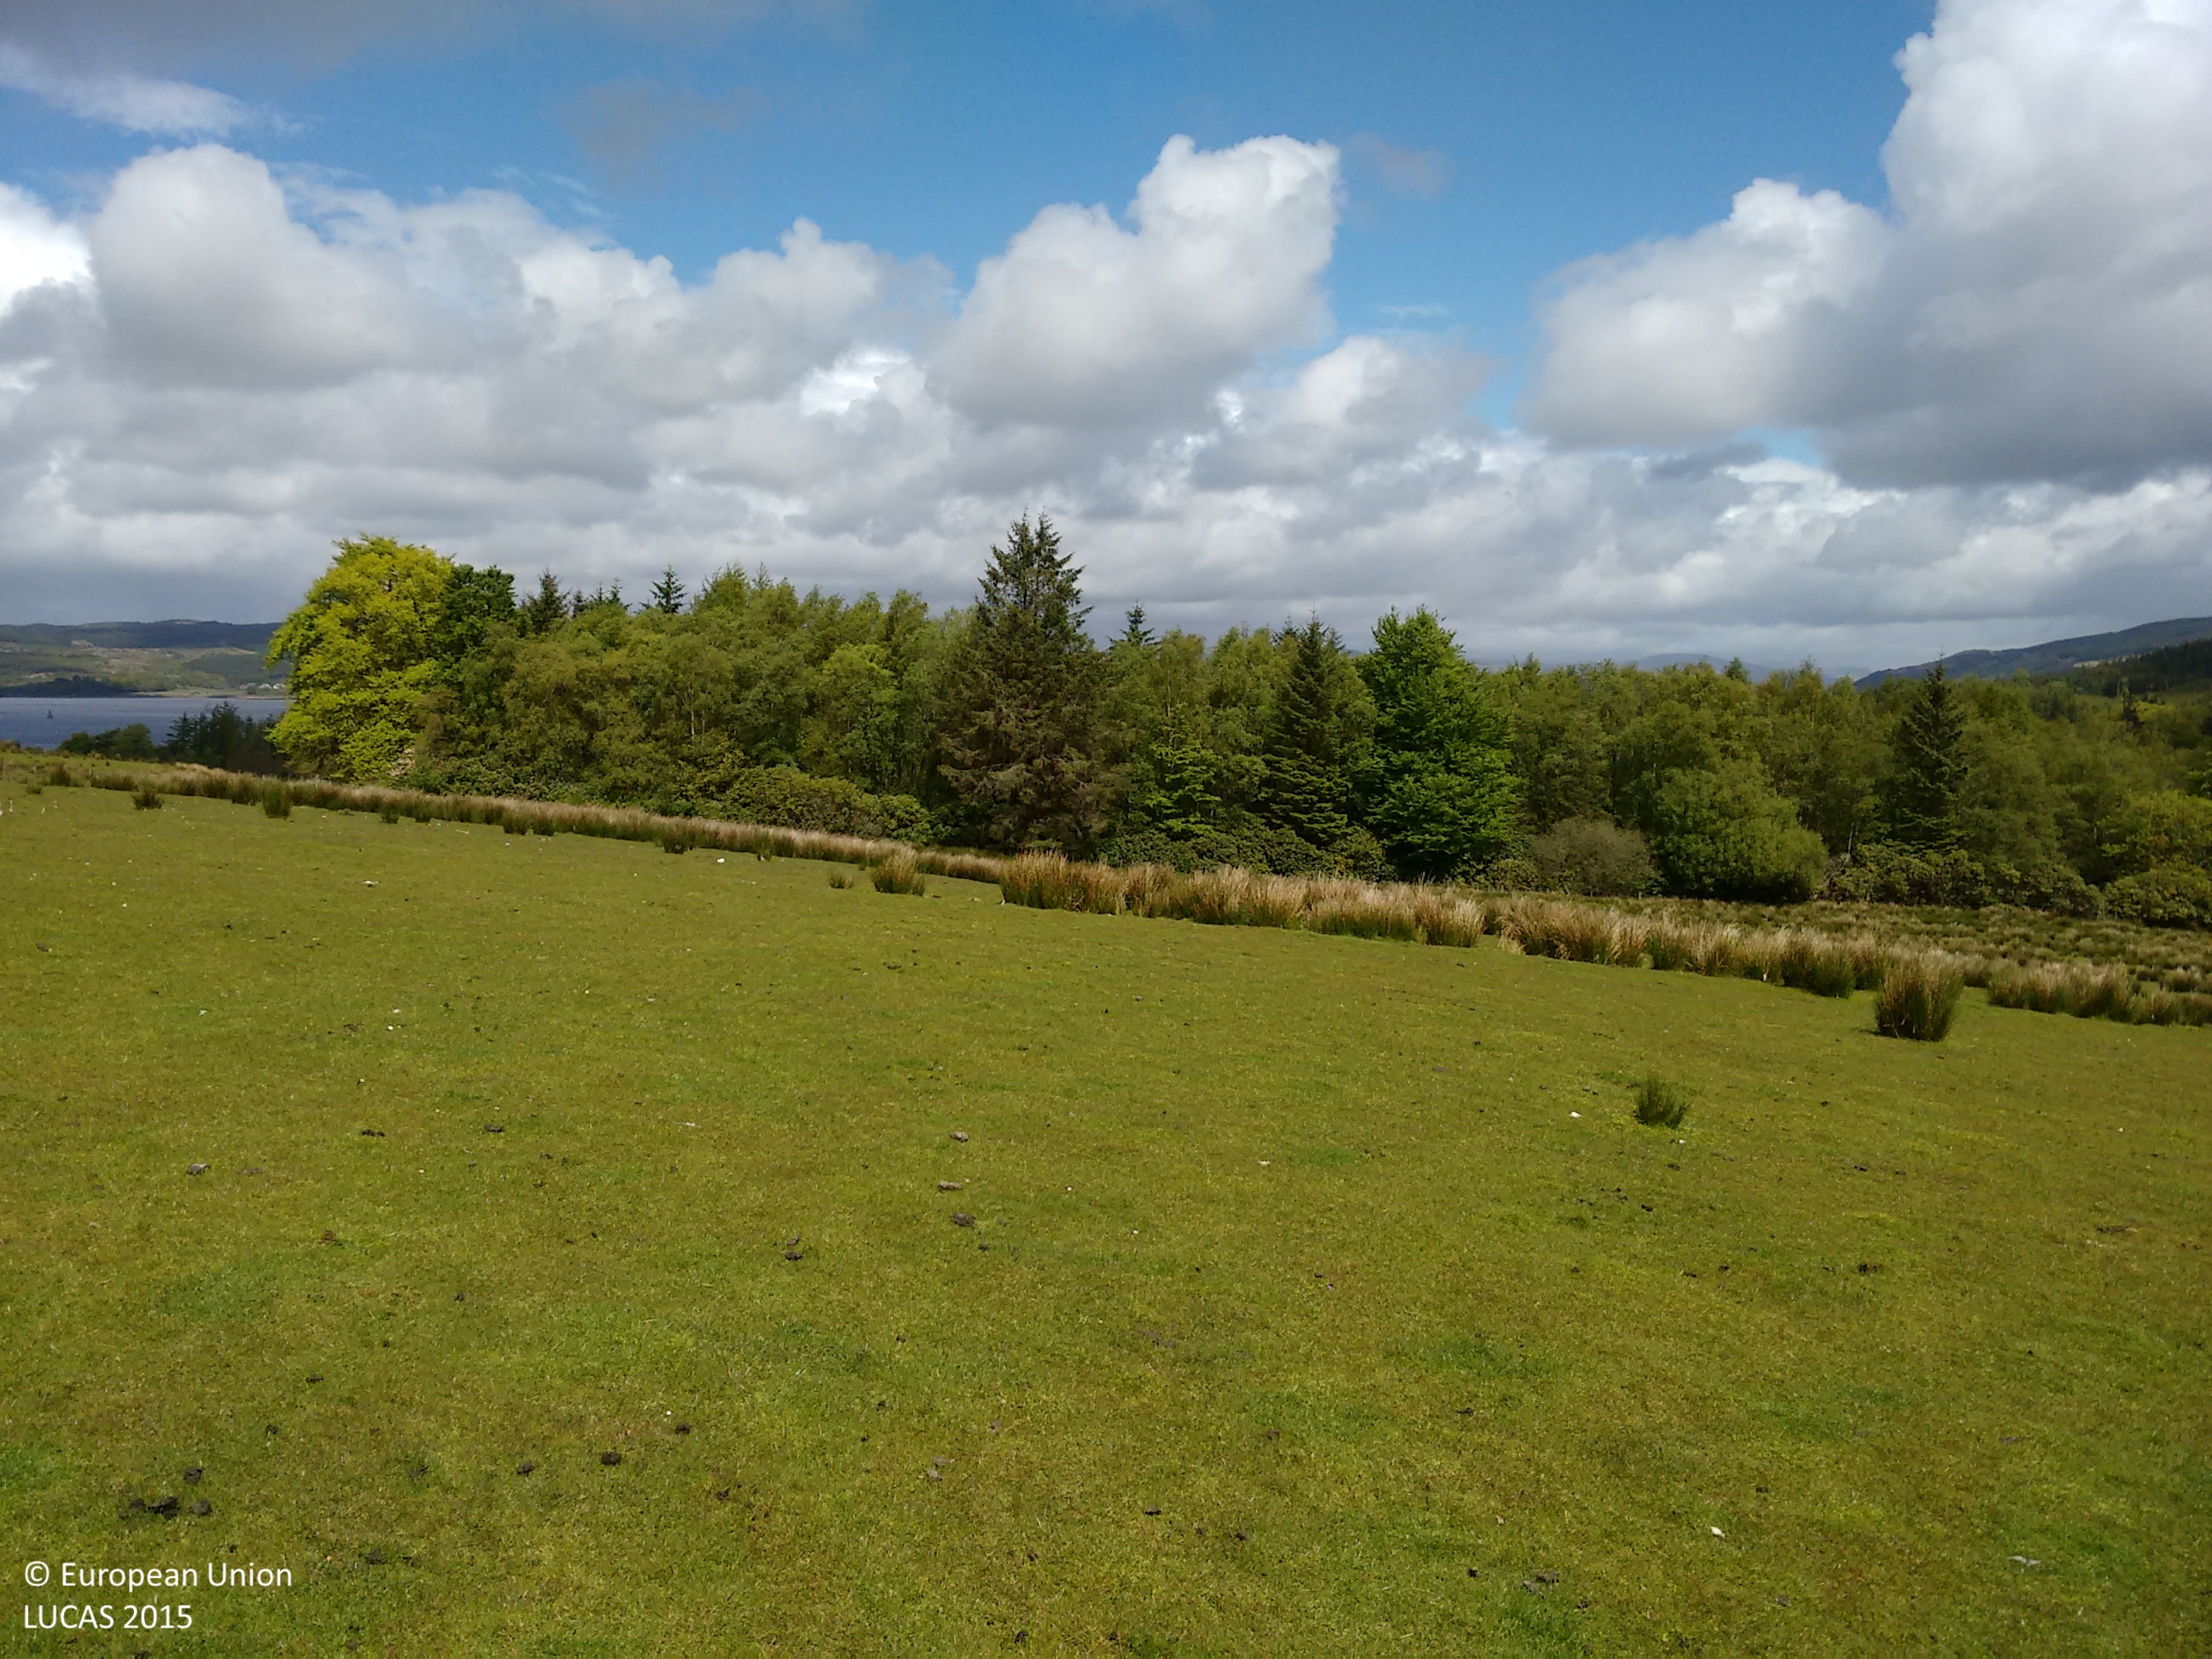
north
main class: Grassland
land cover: Grassland without tree/shrub cover
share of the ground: > 75 %
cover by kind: herbaceous plants 100 %
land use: Agriculture (excluding fallow land and kitchen gardens)
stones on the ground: < 10 %
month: May
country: GB
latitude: 55.9920
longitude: -5.3319
